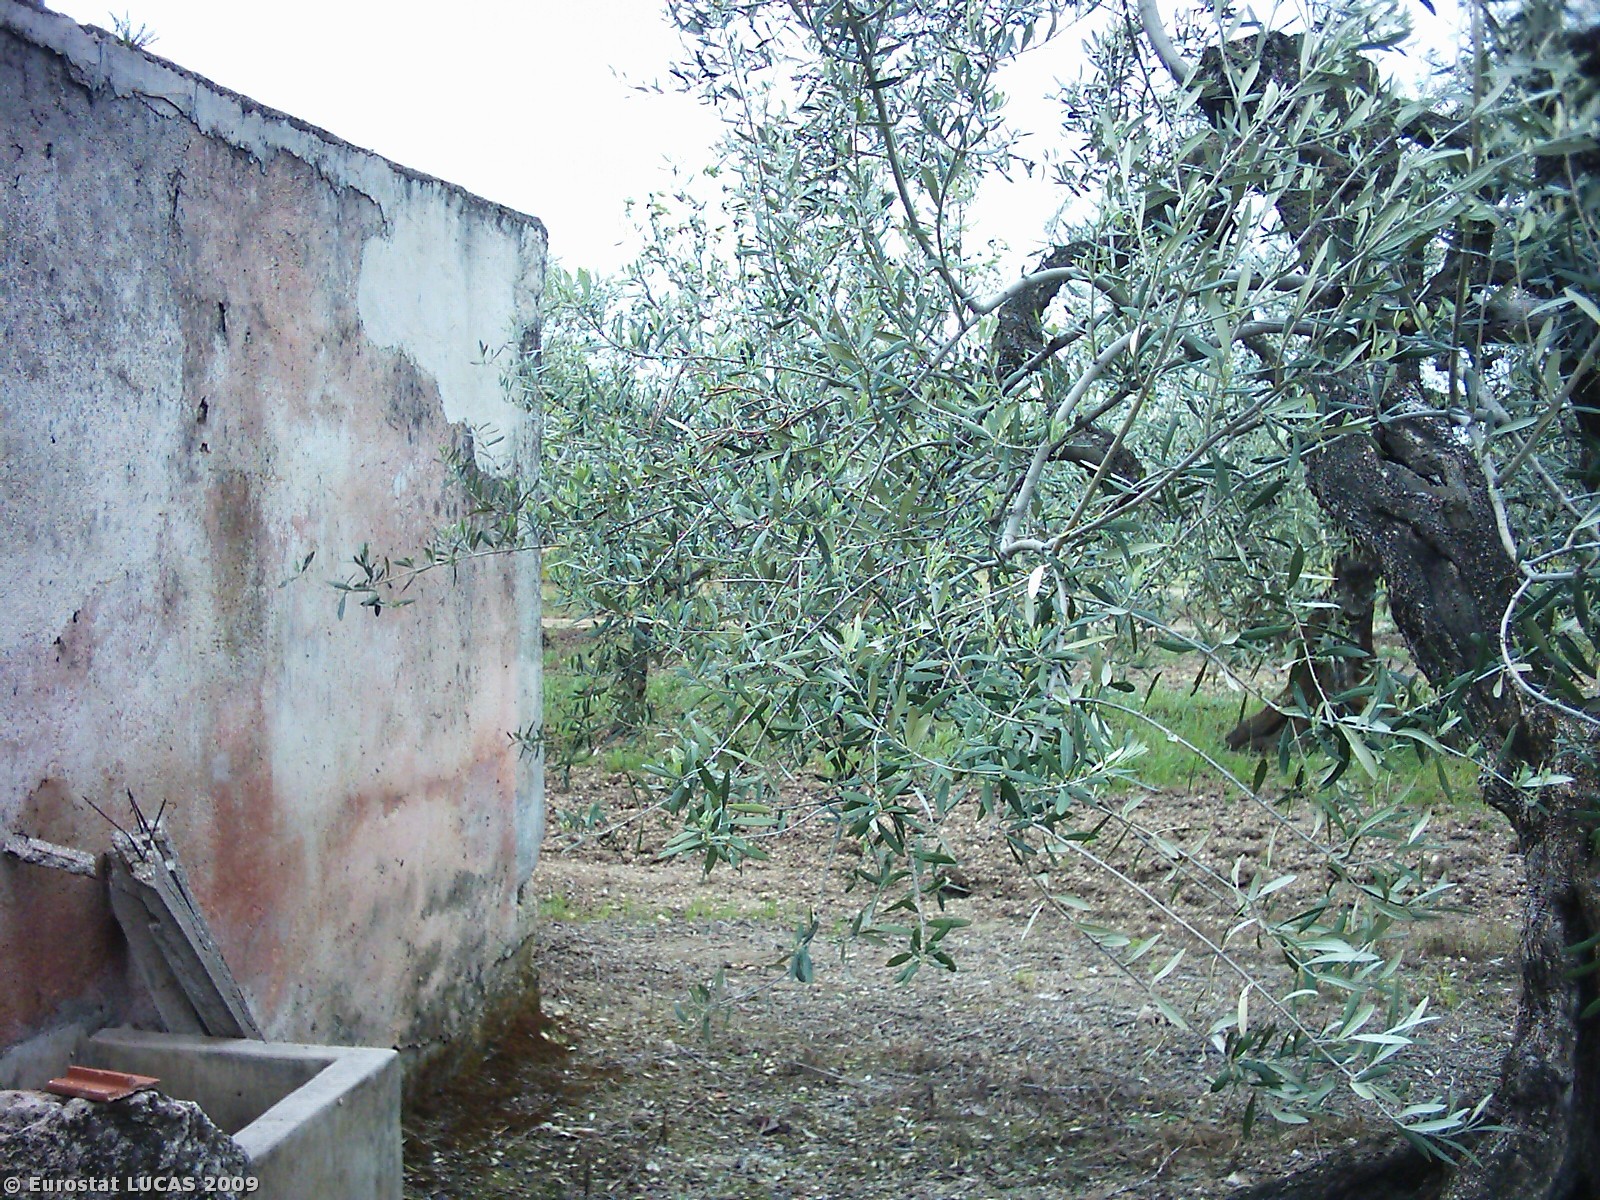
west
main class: Cropland
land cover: Olive groves
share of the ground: 10 - 25 %
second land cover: Bare land
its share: > 75 %
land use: Agriculture (excluding fallow land and kitchen gardens)
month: April
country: IT
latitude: 41.1857
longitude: 16.3581
